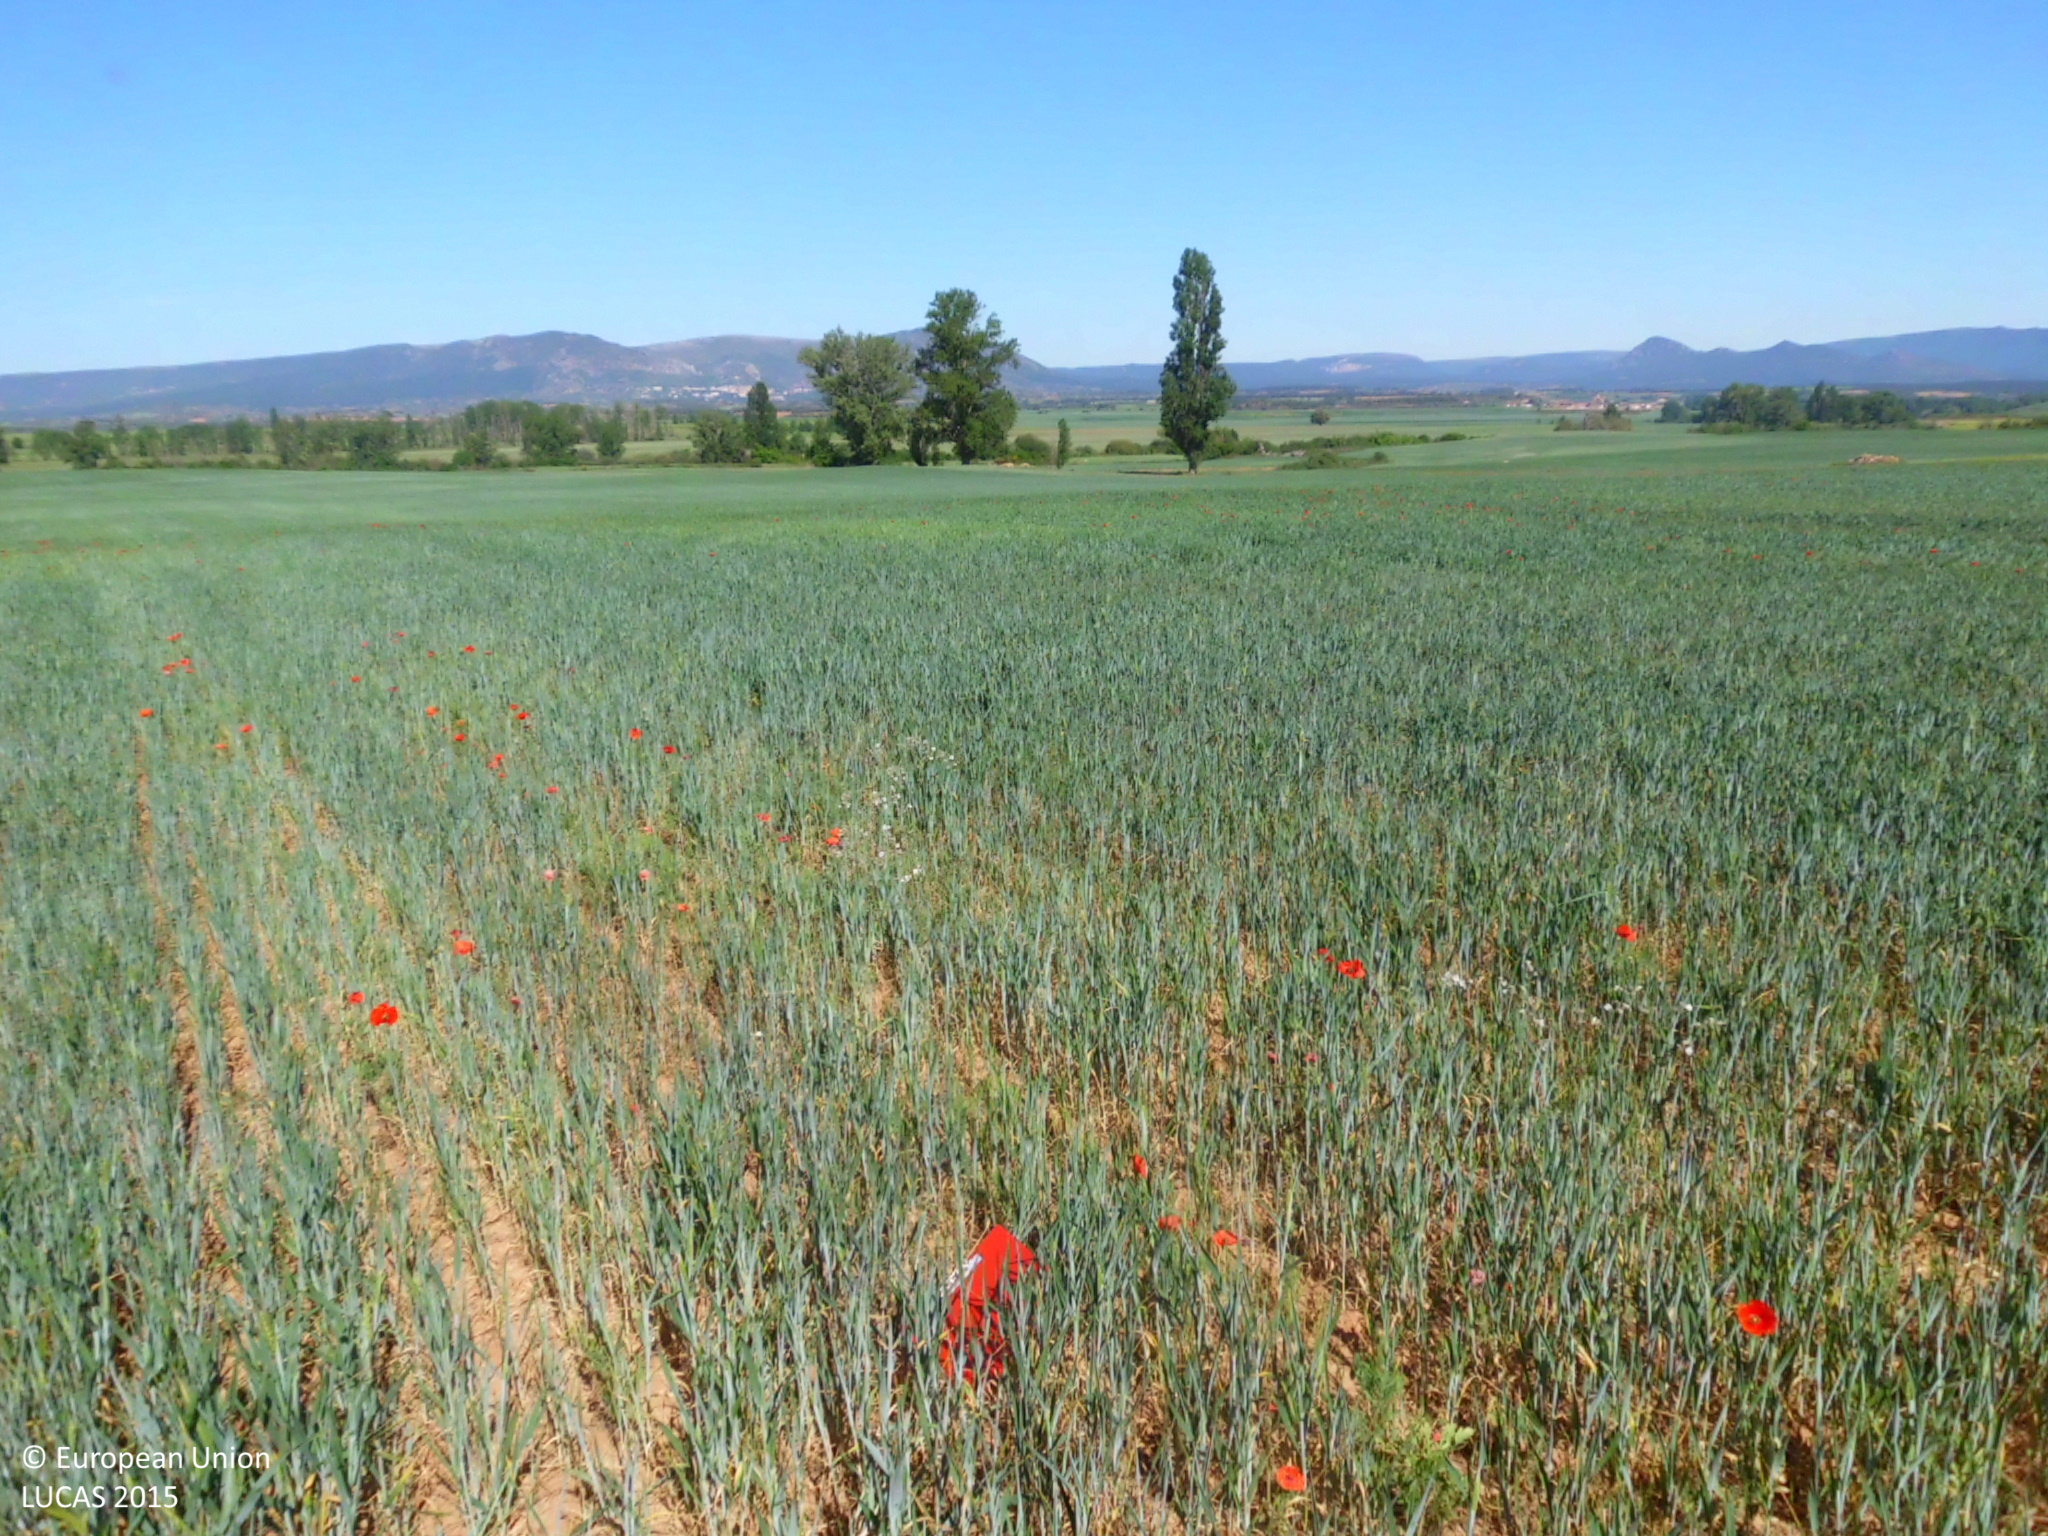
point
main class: Cropland
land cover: Common wheat
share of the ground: 25 - 50 %
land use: Agriculture (excluding fallow land and kitchen gardens)
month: May
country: ES
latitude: 42.6349
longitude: -3.4126
